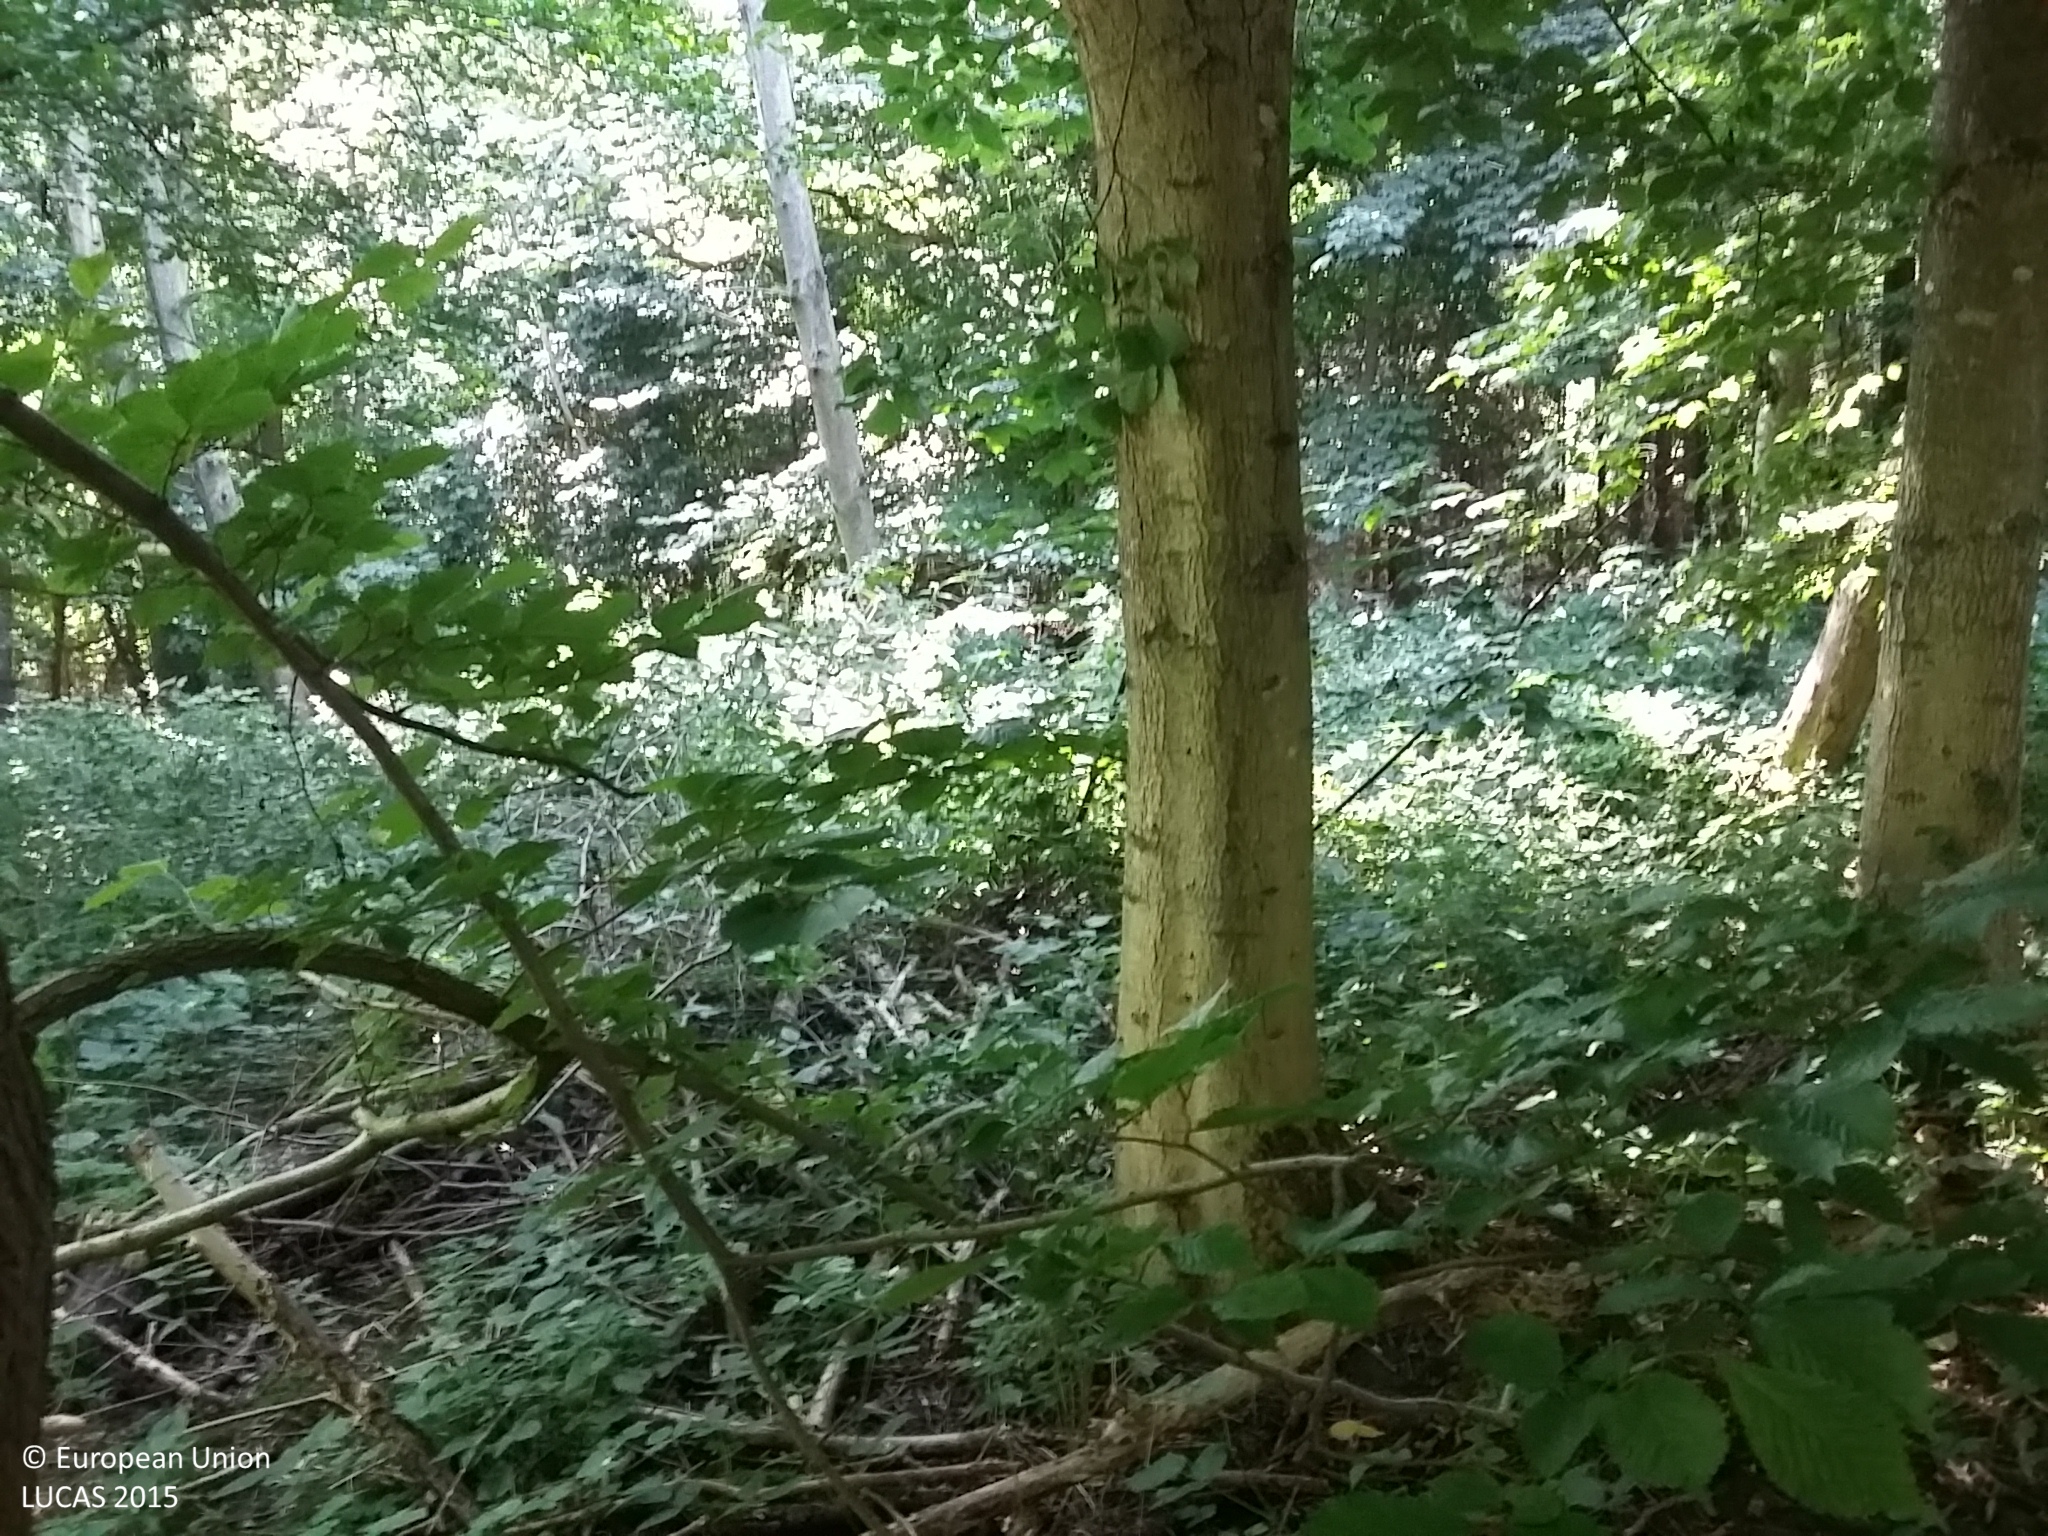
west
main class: Woodland
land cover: Broadleaved woodland
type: beech forest
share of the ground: > 75 %
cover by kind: broadleaved forest trees 80 %, herbaceous plants 20 %
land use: Forestry
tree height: > 5 m
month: August
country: DK
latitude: 55.0915
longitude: 14.7476
